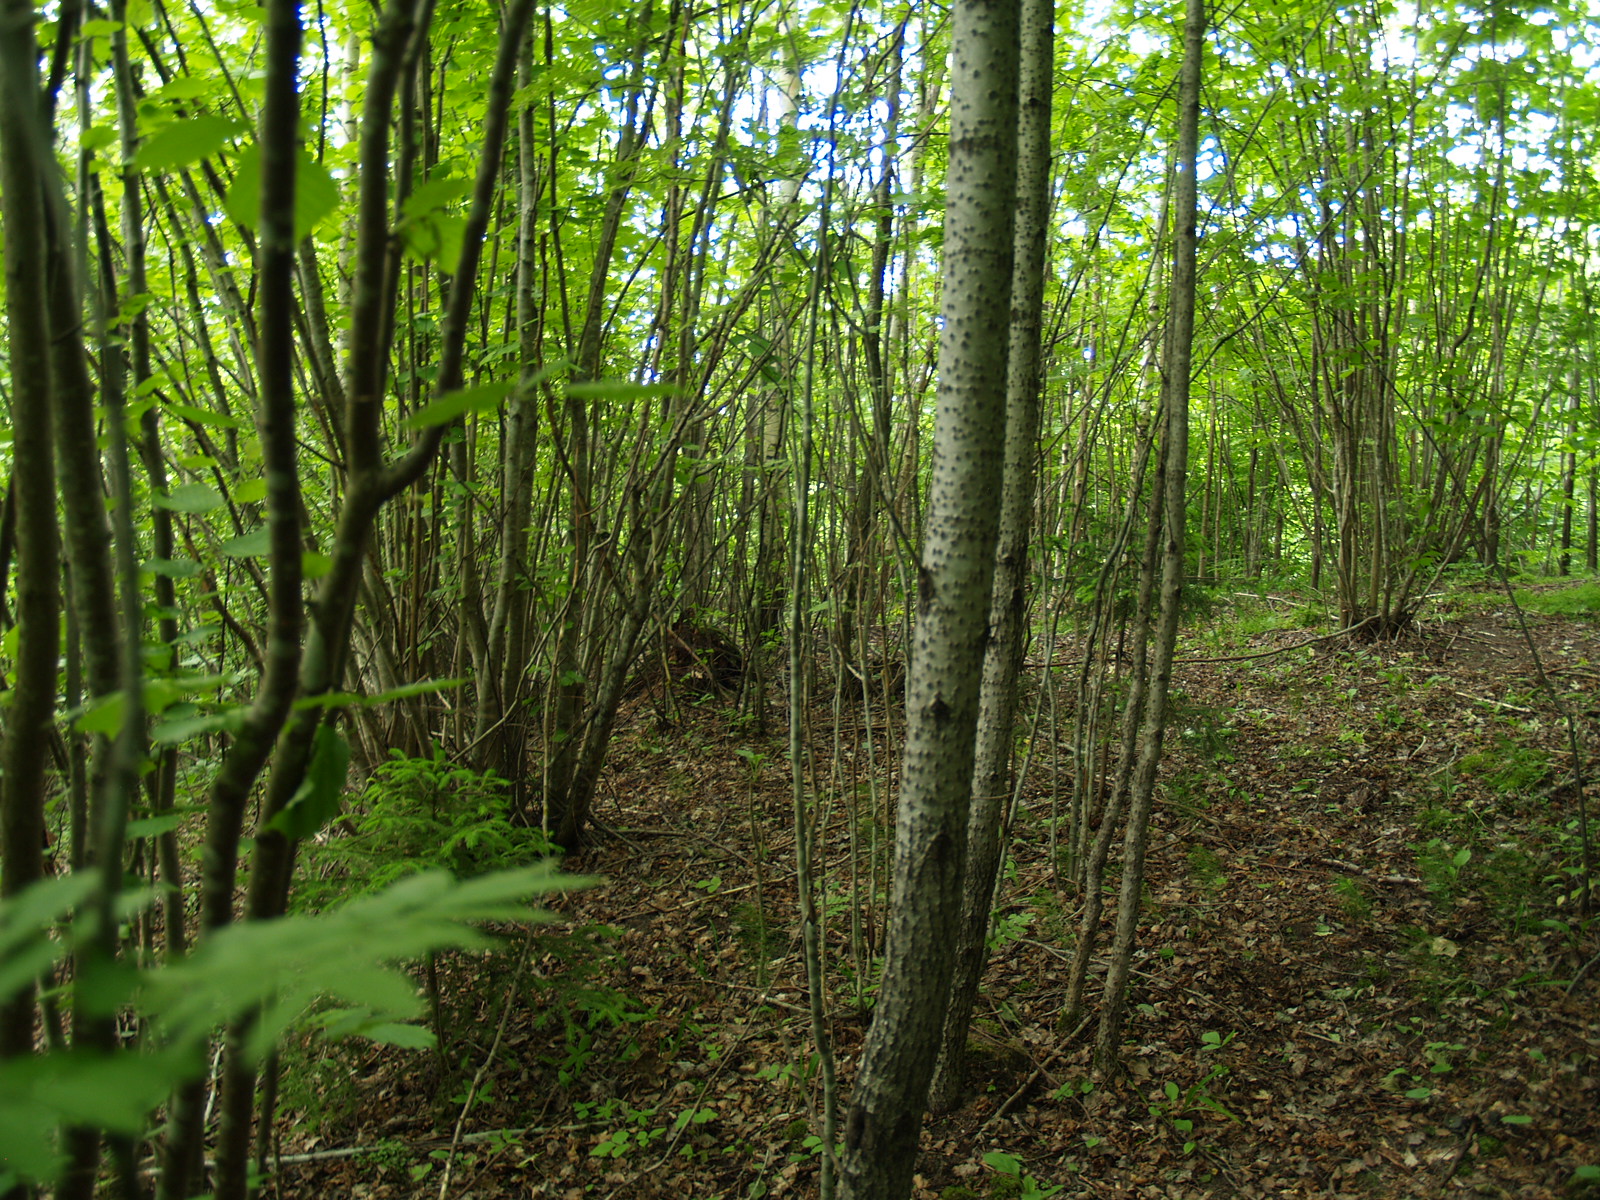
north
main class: Woodland
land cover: Broadleaved woodland
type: non-riverine alder, birch or aspen forest
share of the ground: > 75 %
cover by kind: broadleaved forest trees 100 %
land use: Forestry
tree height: > 5 m
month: June
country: LV
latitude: 56.6275
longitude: 25.6911
